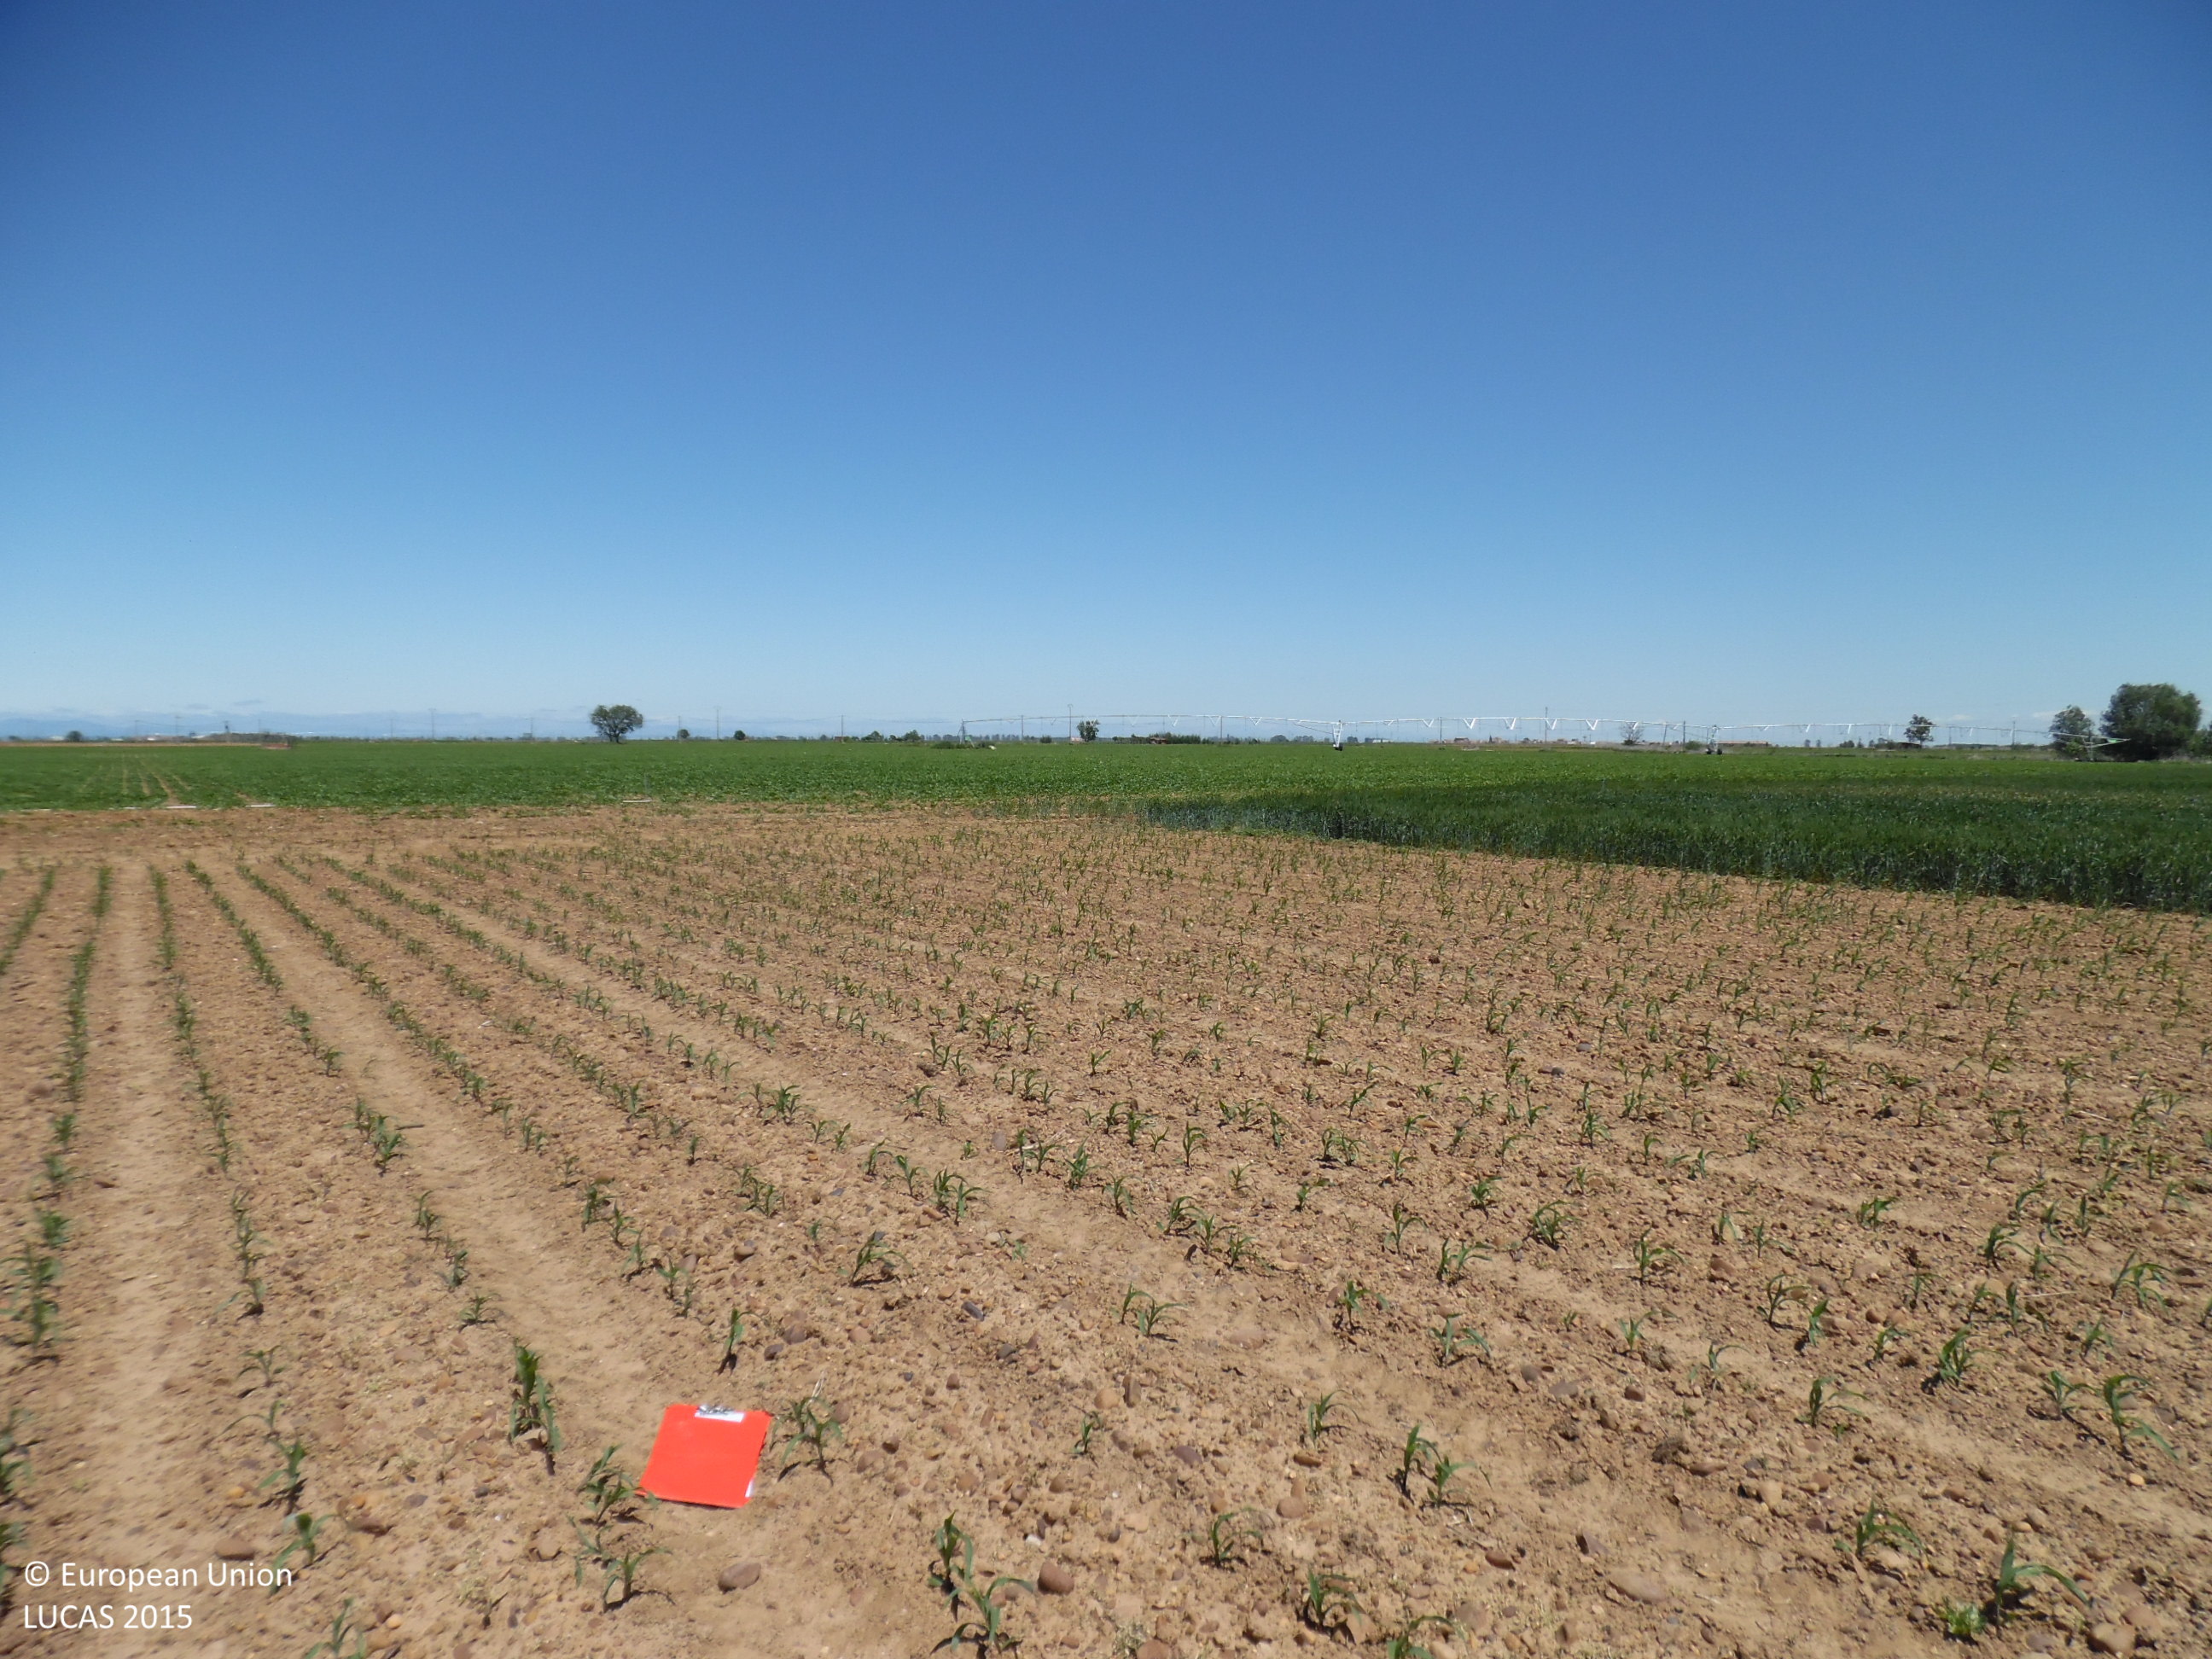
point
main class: Cropland
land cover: Maize
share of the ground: > 75 %
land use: Agriculture (excluding fallow land and kitchen gardens)
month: May
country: ES
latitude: 42.2796
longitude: -5.7269
